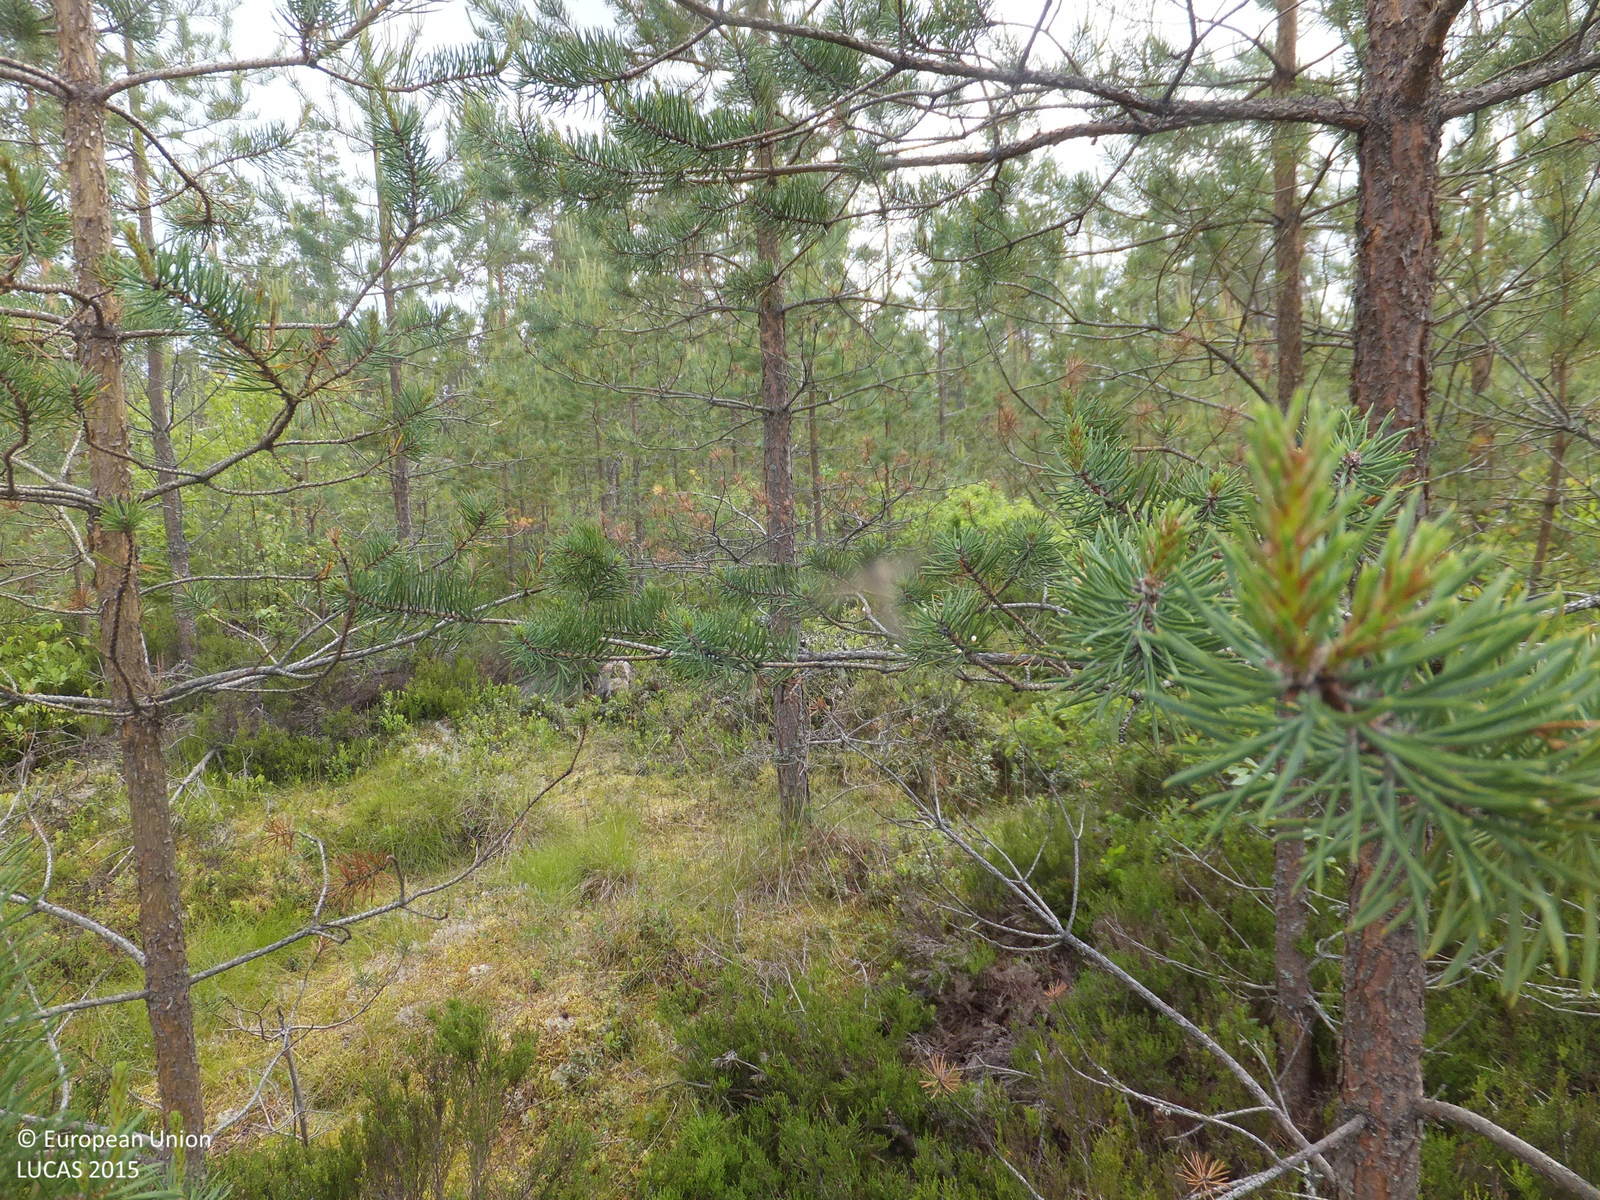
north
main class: Woodland
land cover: Pine dominated coniferous woodland
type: mire and swamp forests
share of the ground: > 75 %
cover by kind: coniferous forest trees 80 %, shrubs 10 %, broadleaved forest trees 5 %, lichens and mosses 5 %
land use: Forestry
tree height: < 5 m
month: June
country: FI
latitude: 63.2836
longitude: 23.9277
